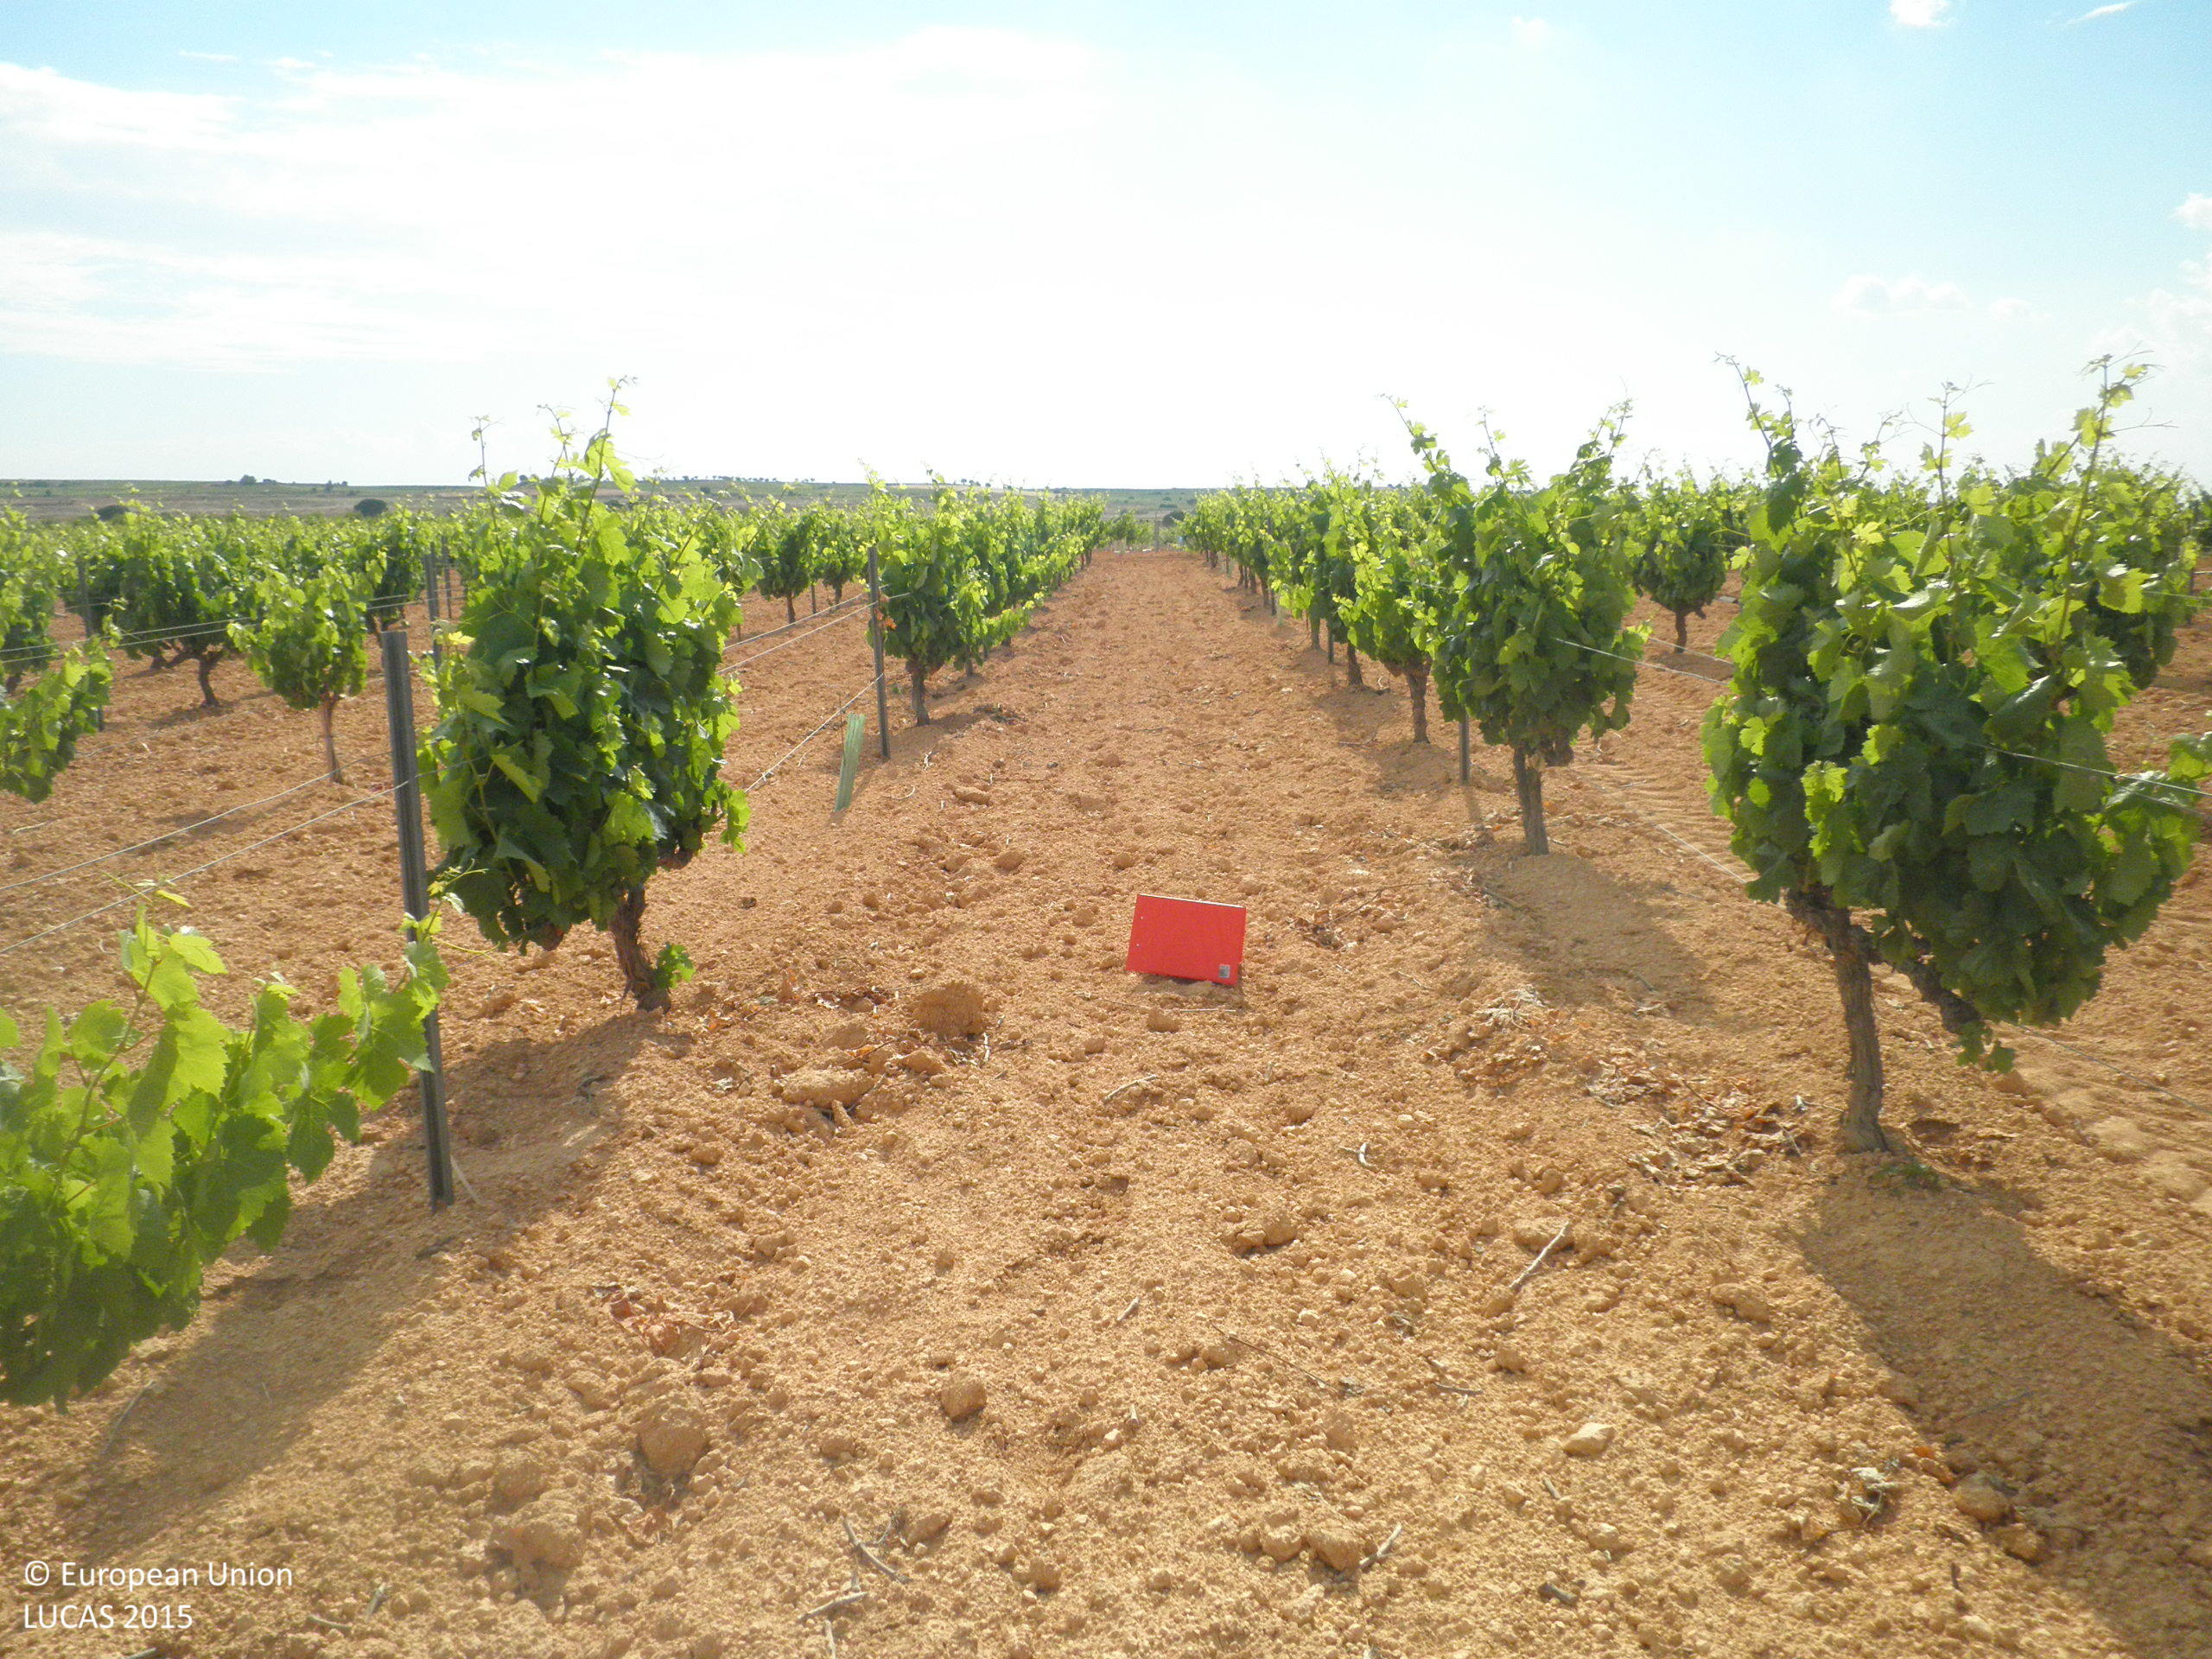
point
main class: Cropland
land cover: Vineyards
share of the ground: < 10 %
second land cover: Other bare soil
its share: > 75 %
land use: Agriculture (excluding fallow land and kitchen gardens)
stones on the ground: < 10 %
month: June
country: ES
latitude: 39.3139
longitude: -1.6590
